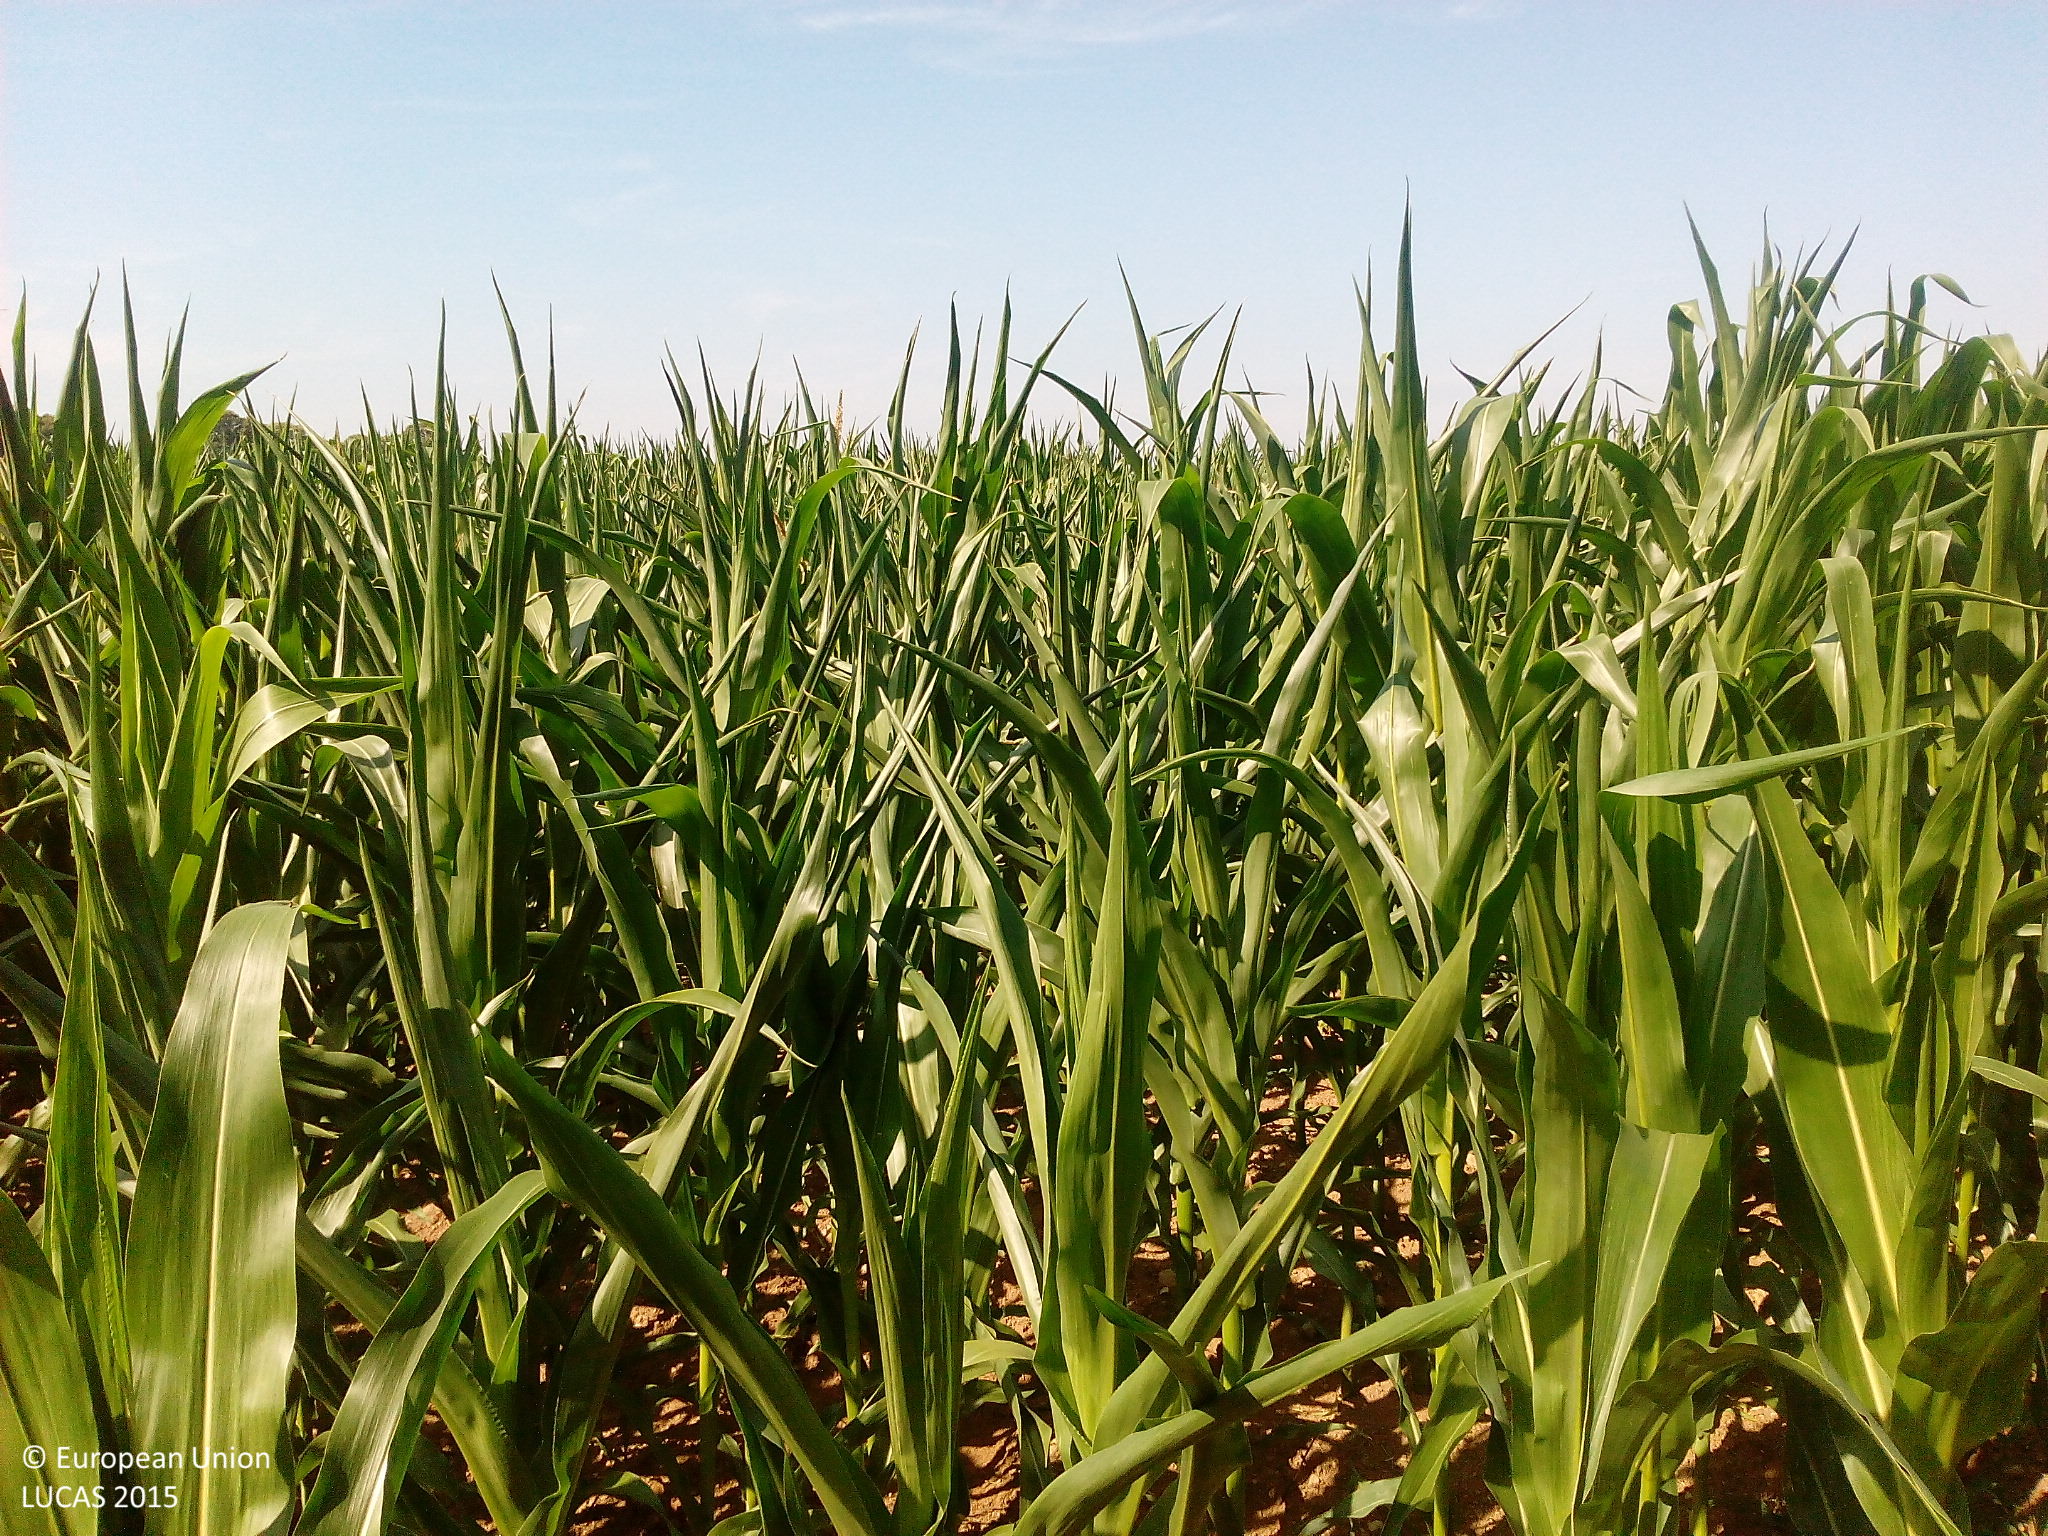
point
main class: Cropland
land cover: Maize
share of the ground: > 75 %
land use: Agriculture (excluding fallow land and kitchen gardens)
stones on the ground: 10 - 25 %
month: August
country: DE
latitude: 53.6107
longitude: 12.4630
